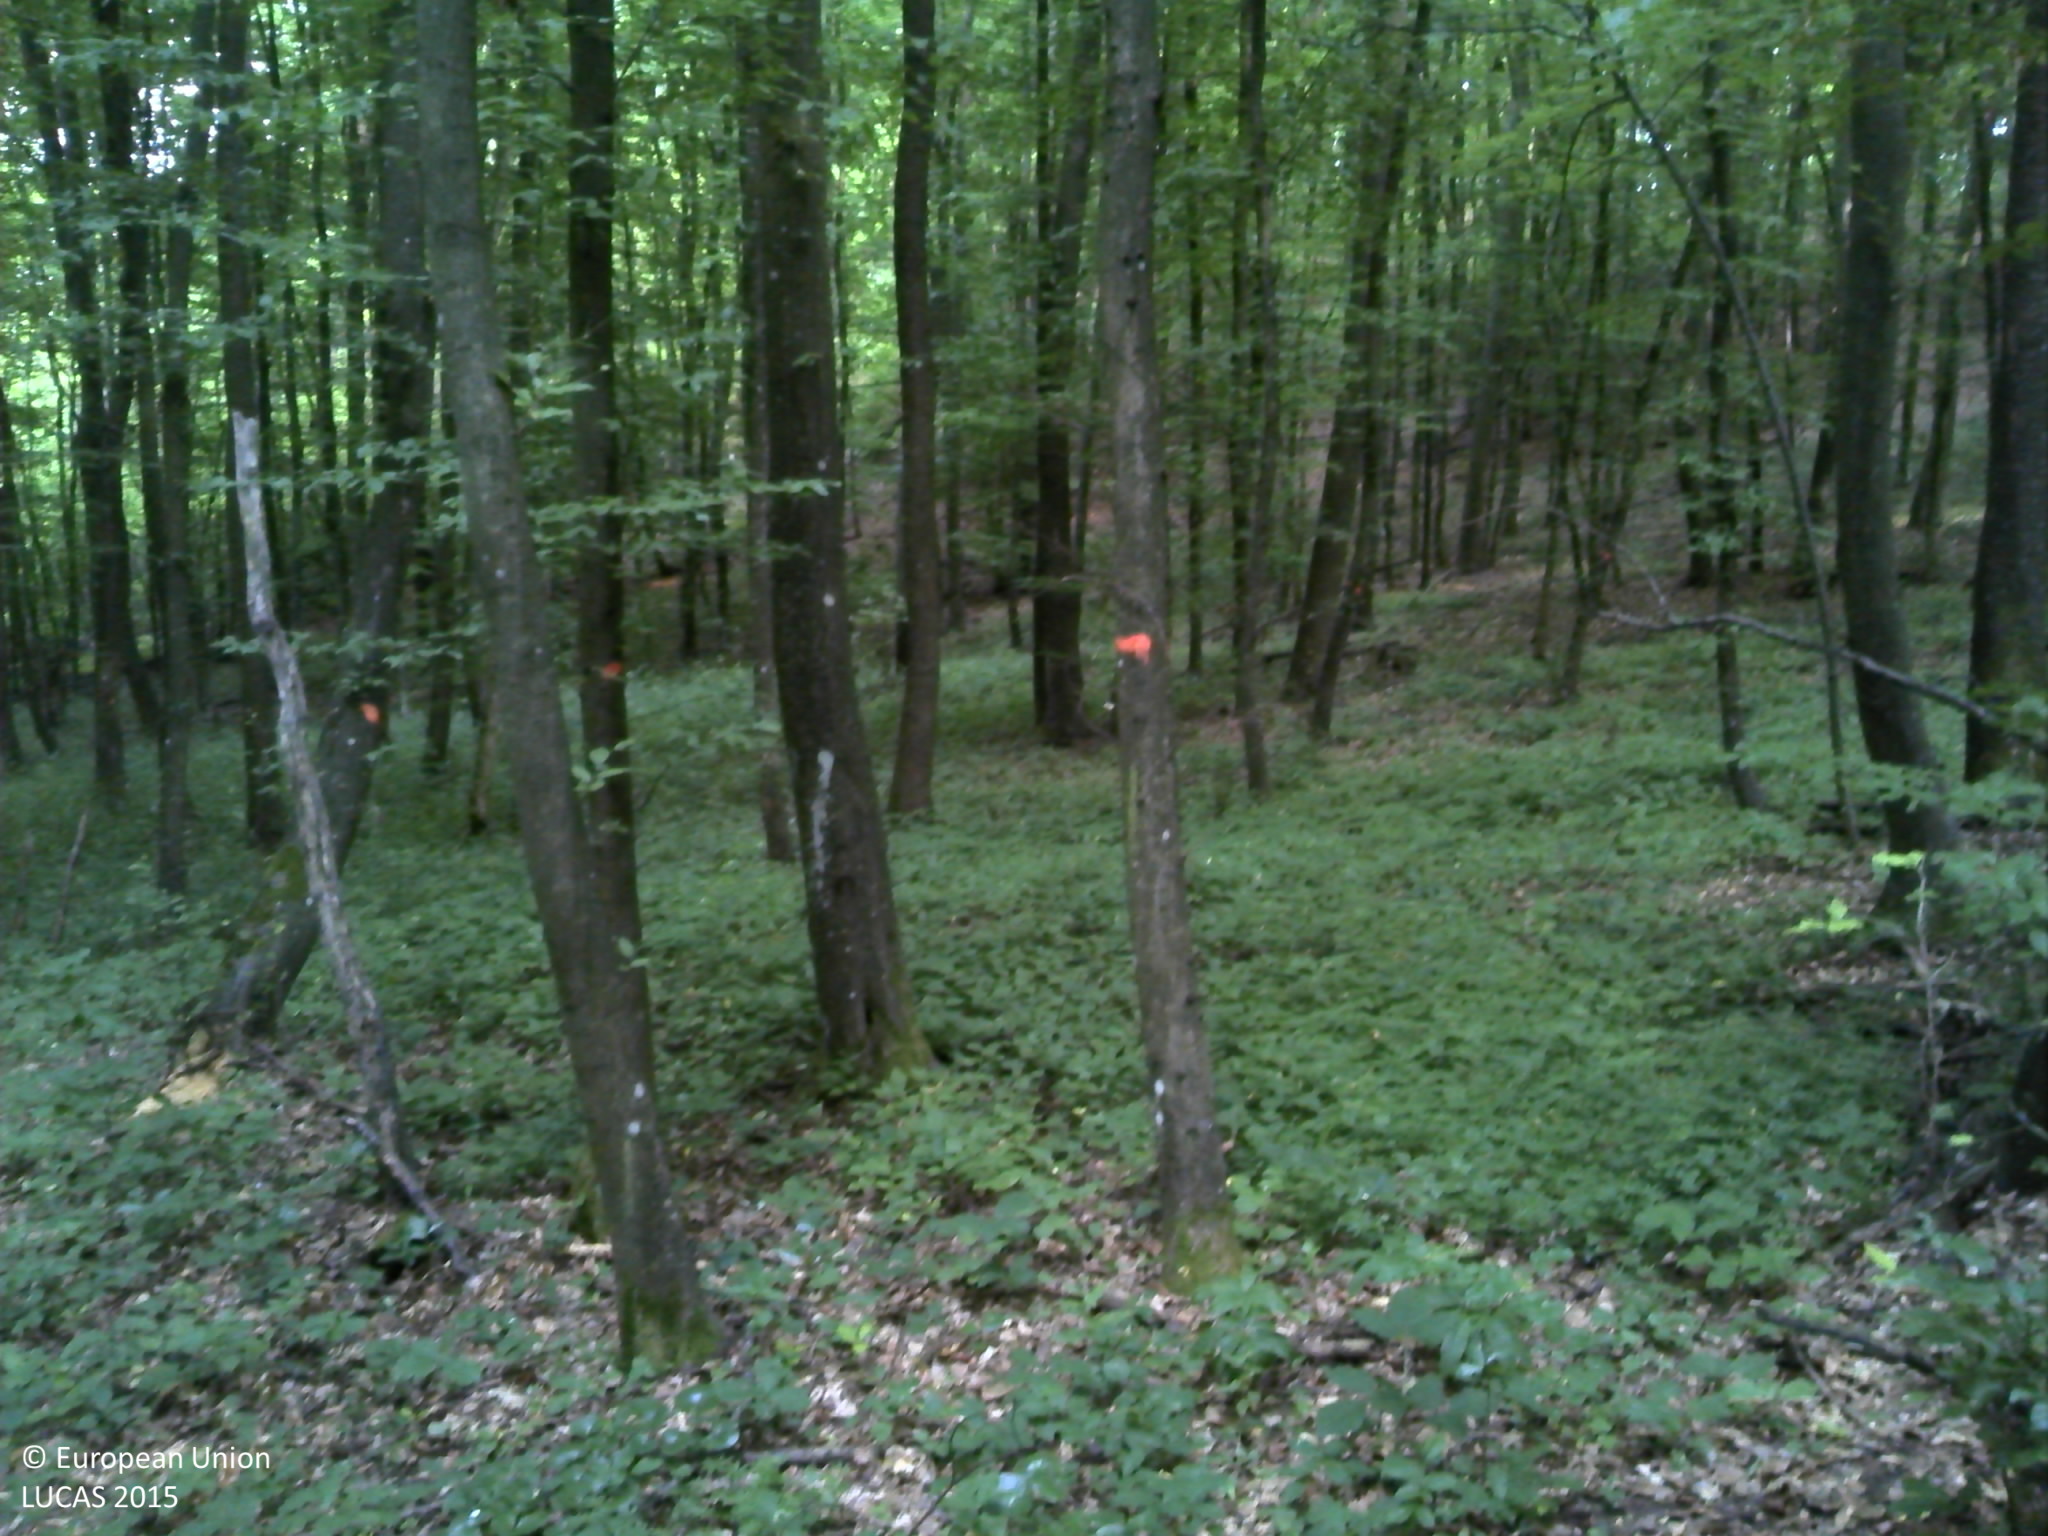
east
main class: Woodland
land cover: Broadleaved woodland
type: beech forest
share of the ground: > 75 %
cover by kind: broadleaved forest trees 90 %, herbaceous plants 5 %, lichens and mosses 5 %
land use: Forestry
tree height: > 5 m
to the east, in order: Broadleaved woodland
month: June
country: HR
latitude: 45.2597
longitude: 18.1722
